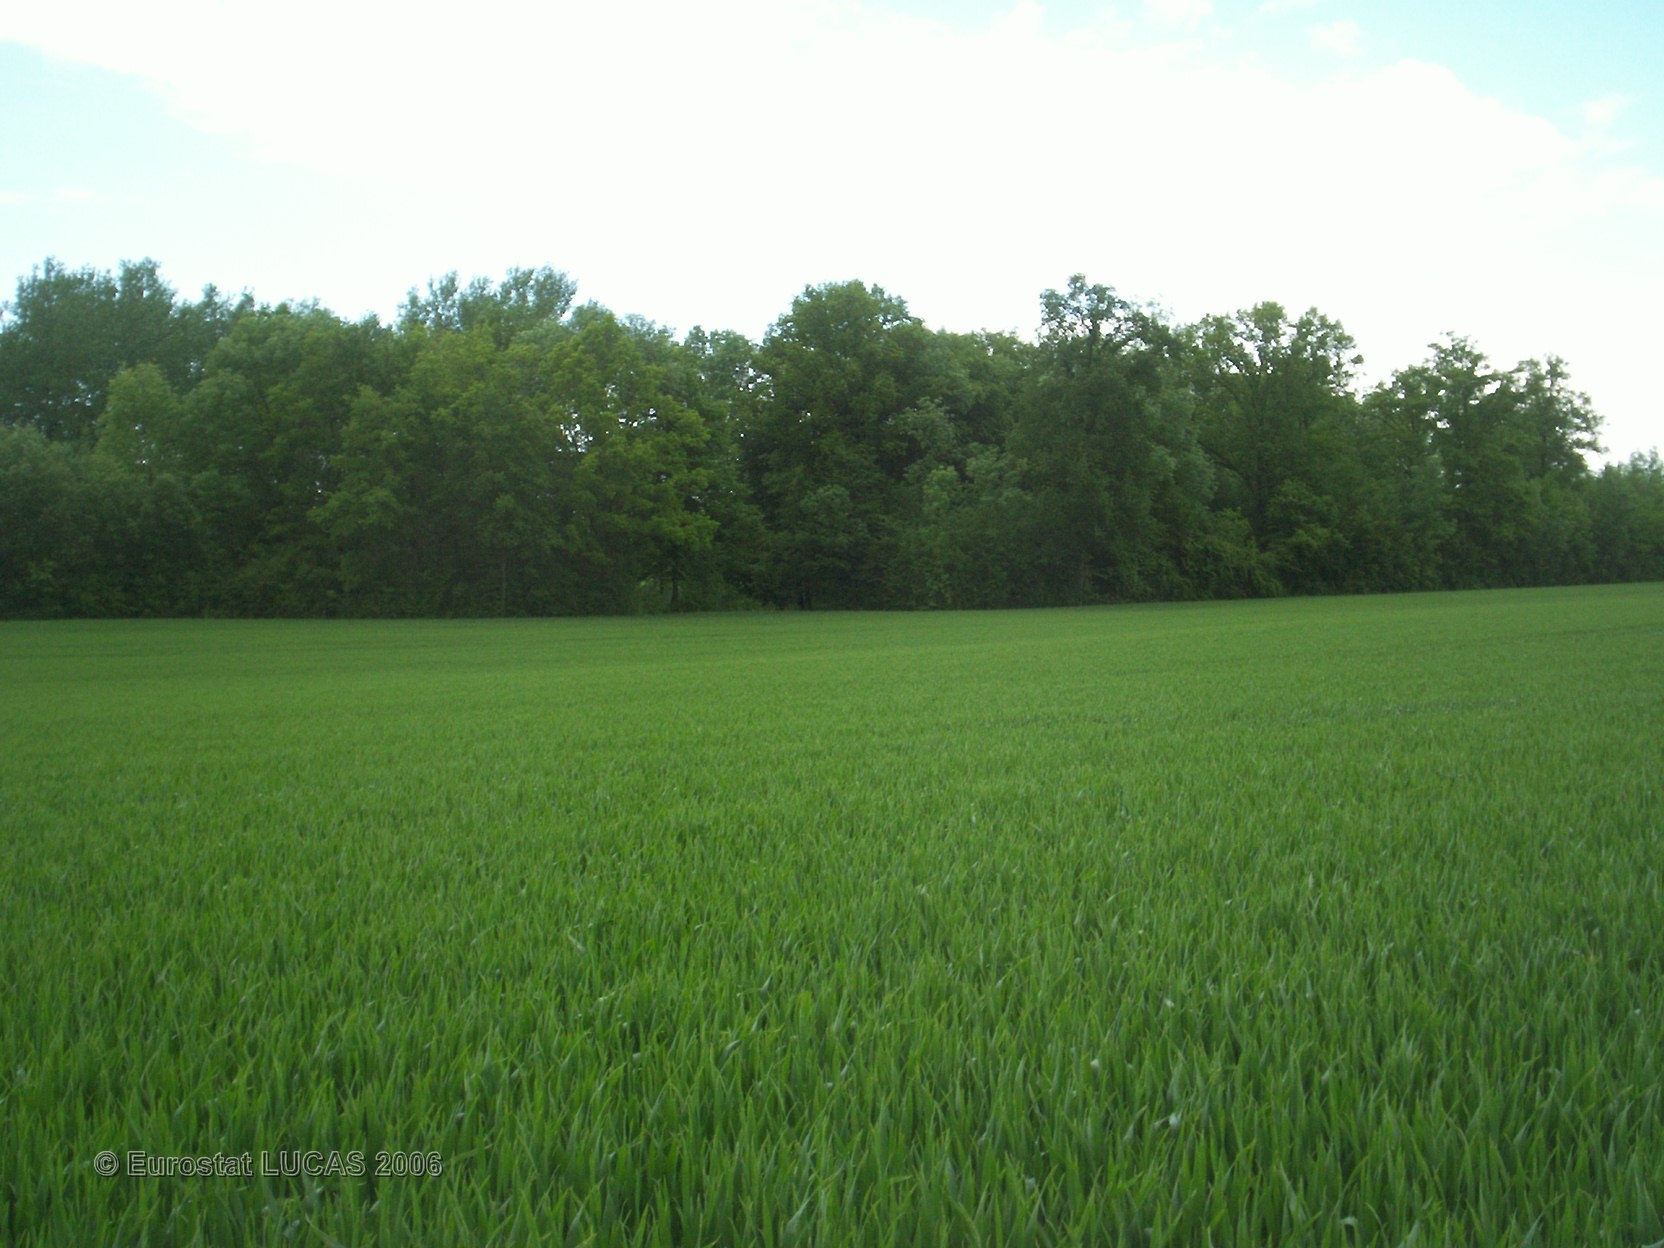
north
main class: Cropland
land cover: Common wheat
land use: Agriculture (excluding fallow land and kitchen gardens)
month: May
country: FR
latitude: 49.4424
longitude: 4.5764
